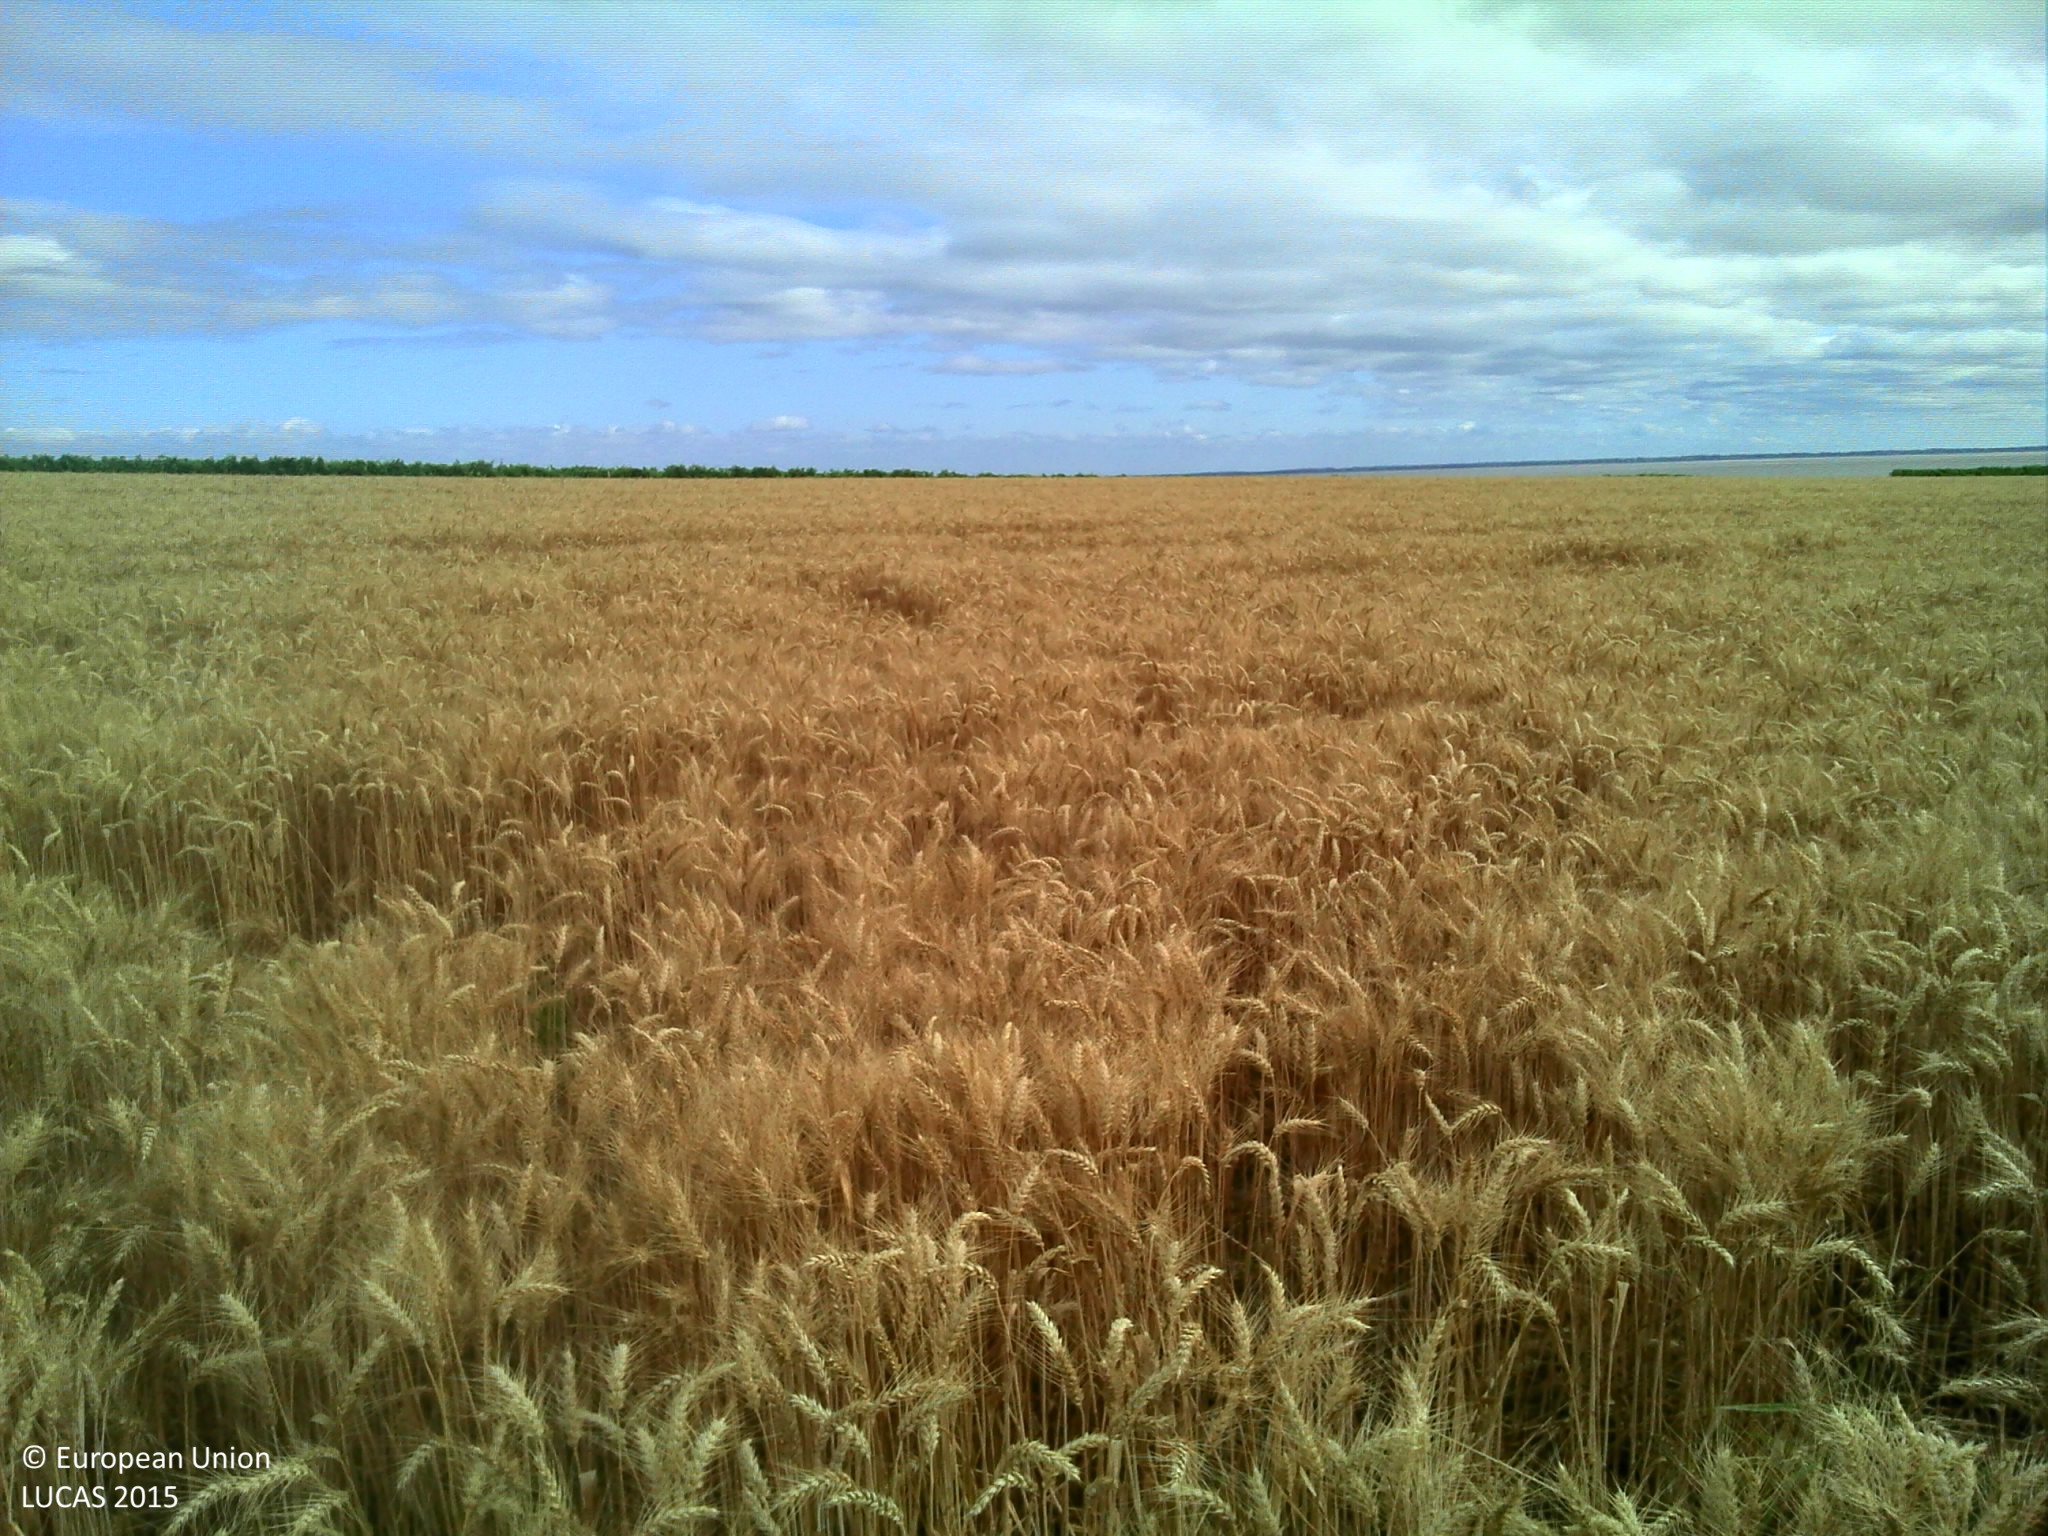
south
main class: Cropland
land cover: Durum wheat
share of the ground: > 75 %
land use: Agriculture (excluding fallow land and kitchen gardens)
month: July
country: FR
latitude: 45.5079
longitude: -0.8405
